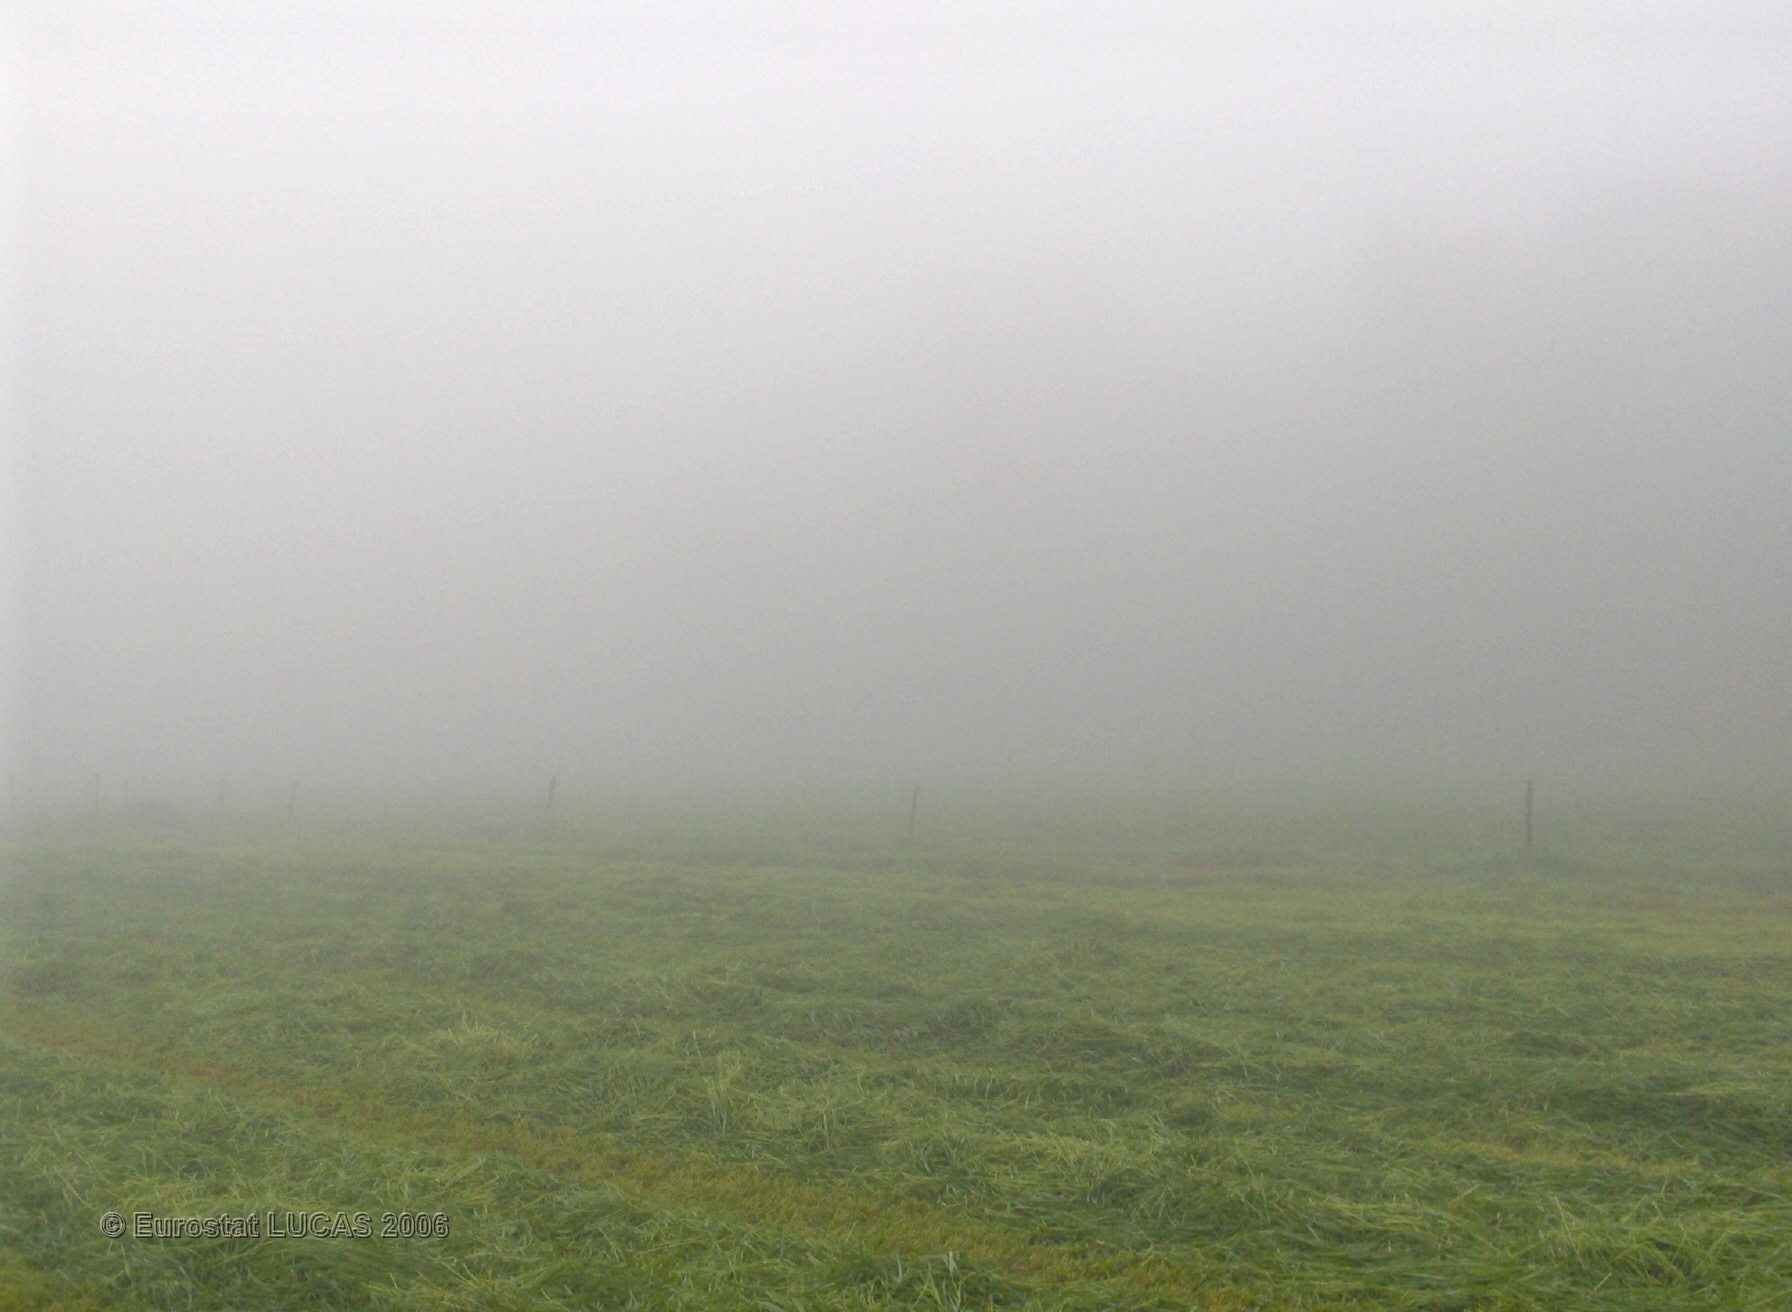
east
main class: Grassland
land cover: Grassland without tree/shrub cover
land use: Agriculture (excluding fallow land and kitchen gardens)
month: May
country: BE
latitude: 50.9837
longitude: 5.1971
